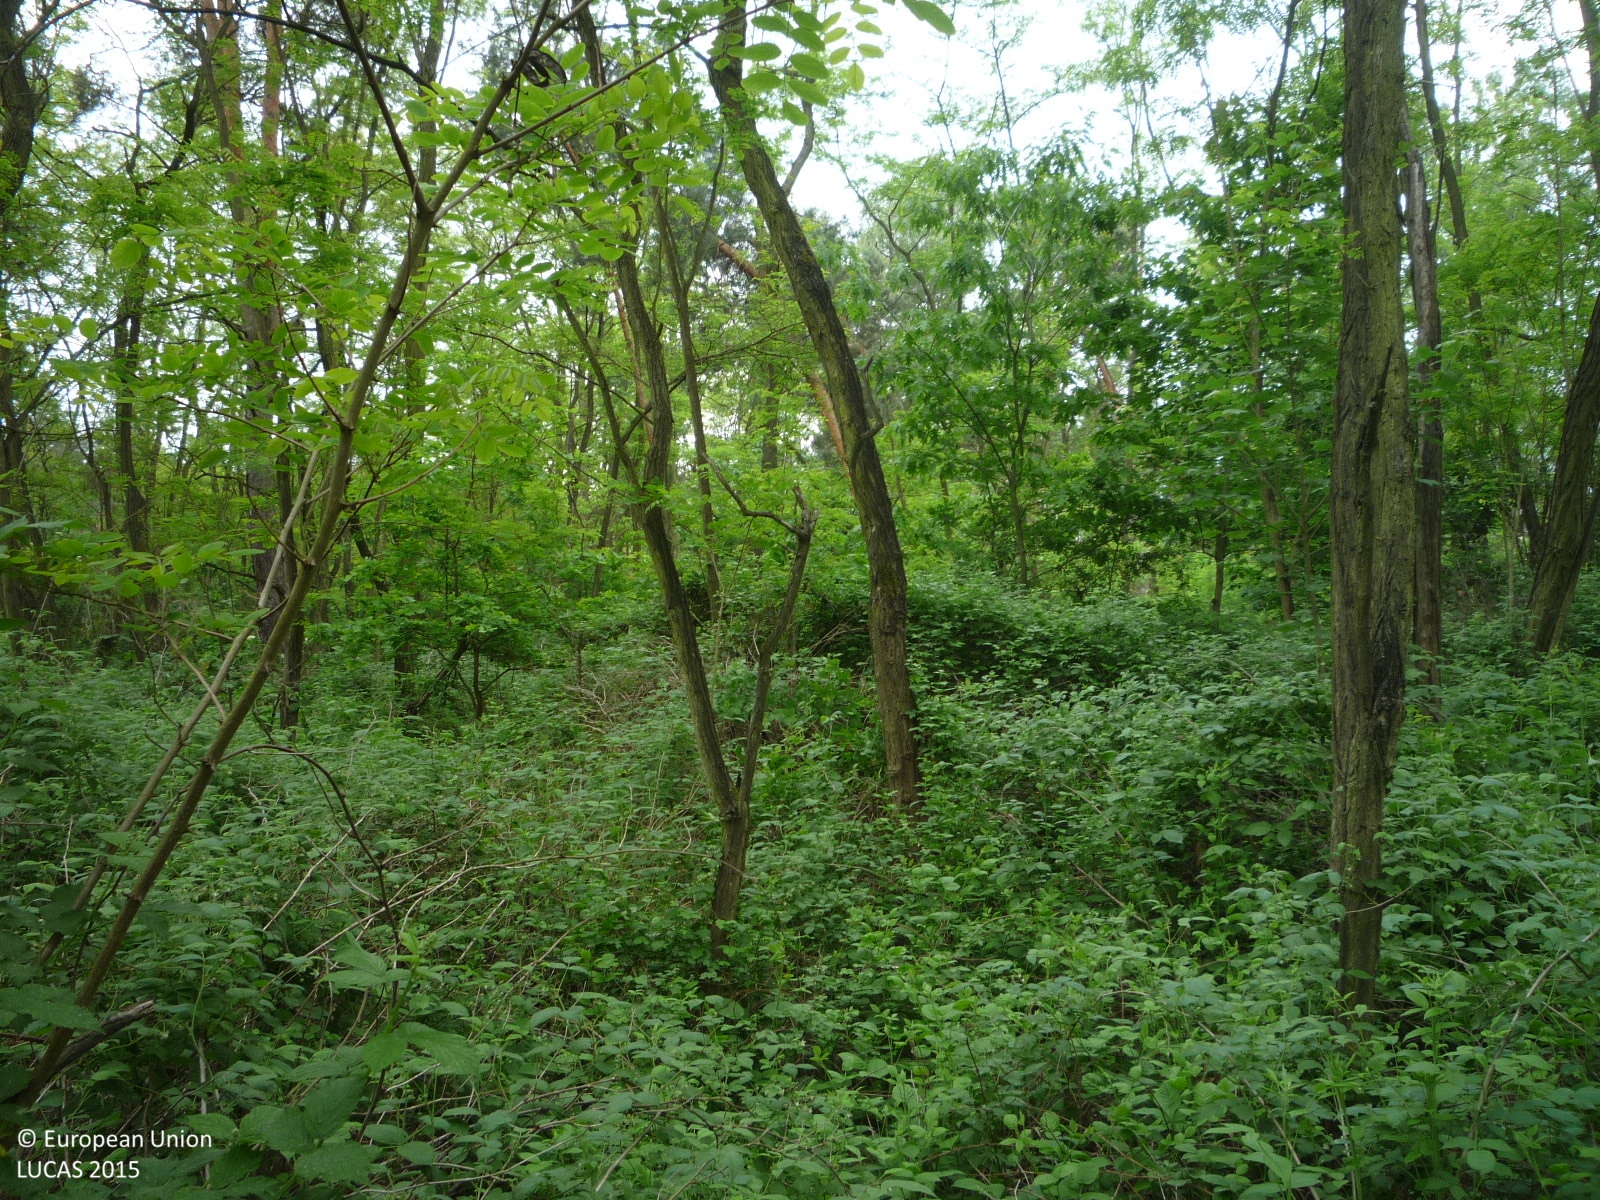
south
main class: Woodland
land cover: Broadleaved woodland
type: mesophytic deciduous forest
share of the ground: > 75 %
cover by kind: broadleaved forest trees 90 %, shrubs 10 %
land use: Forestry
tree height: > 5 m
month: May
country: CZ
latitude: 50.3841
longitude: 14.4881
